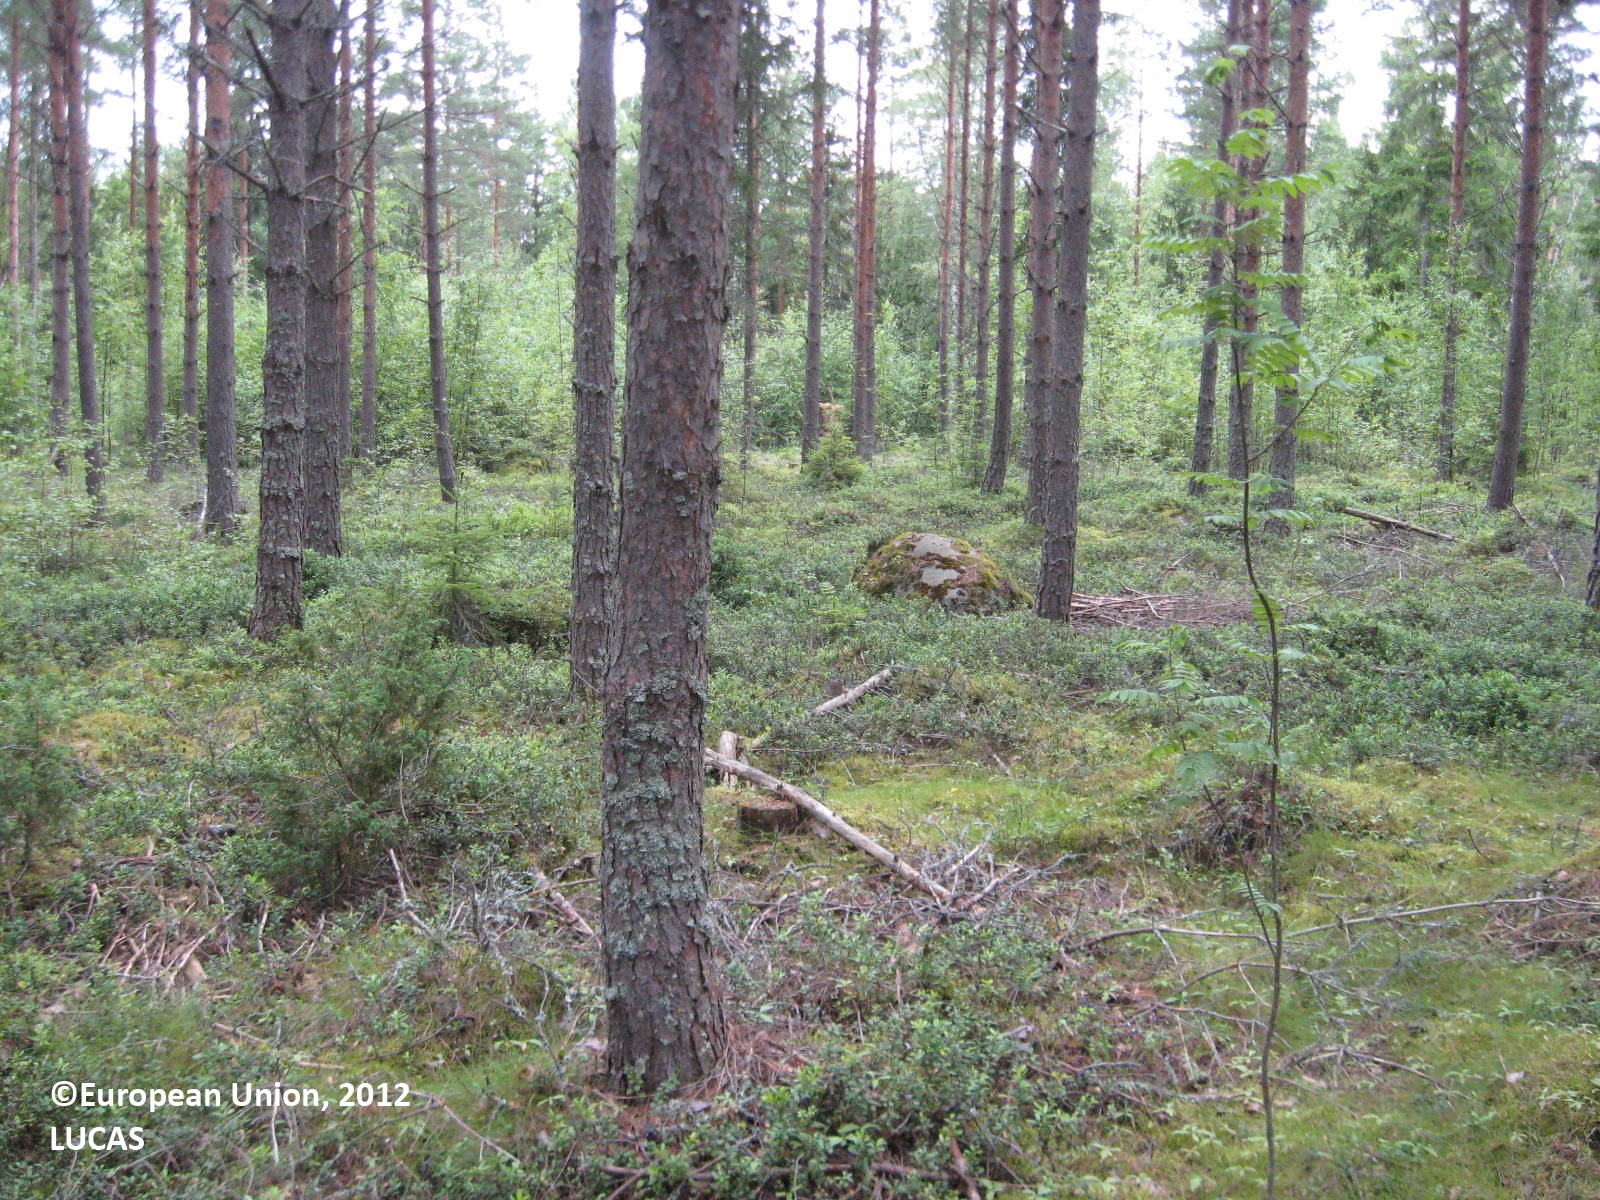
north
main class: Woodland
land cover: Pine dominated coniferous woodland
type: boreal forest
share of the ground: > 75 %
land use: Forestry
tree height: > 5 m
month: July
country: FI
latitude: 62.4854
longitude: 21.1970
